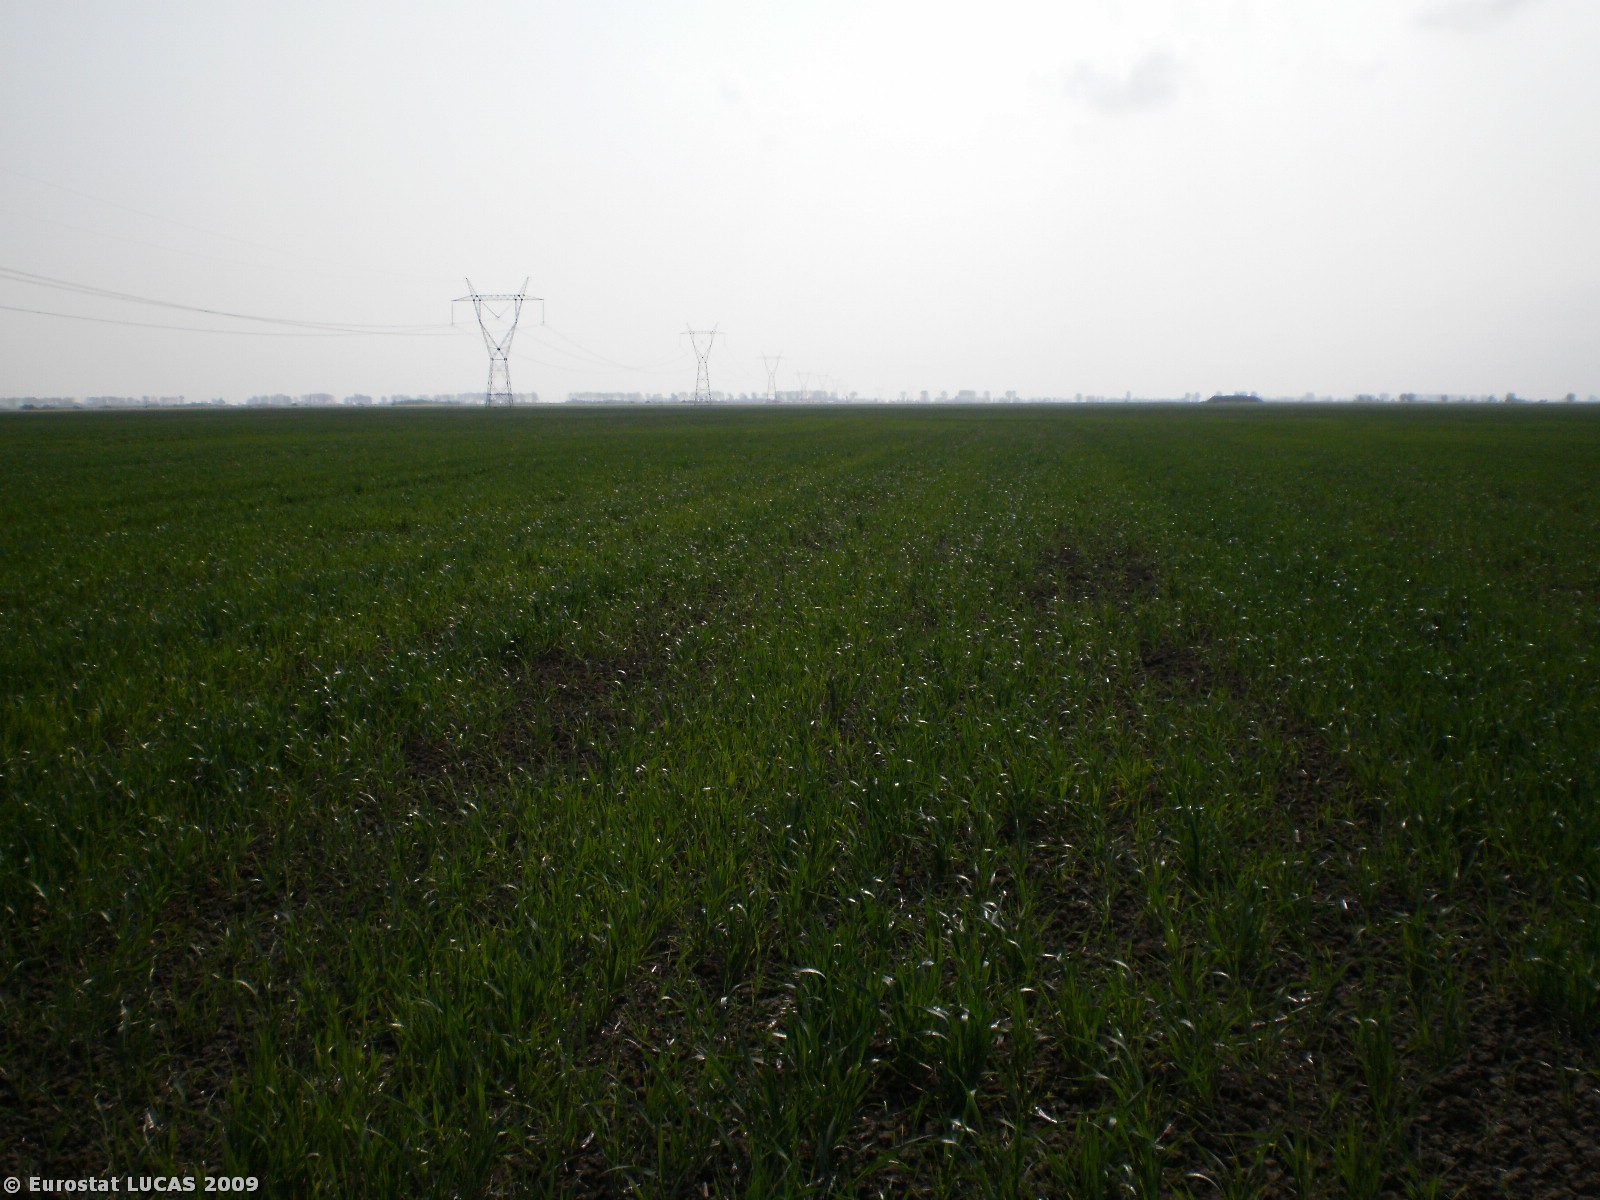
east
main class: Cropland
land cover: Common wheat
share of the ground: > 75 %
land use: Agriculture (excluding fallow land and kitchen gardens)
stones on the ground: < 10 %
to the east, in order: Common wheat
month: May
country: PL
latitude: 54.2603
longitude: 19.0019
